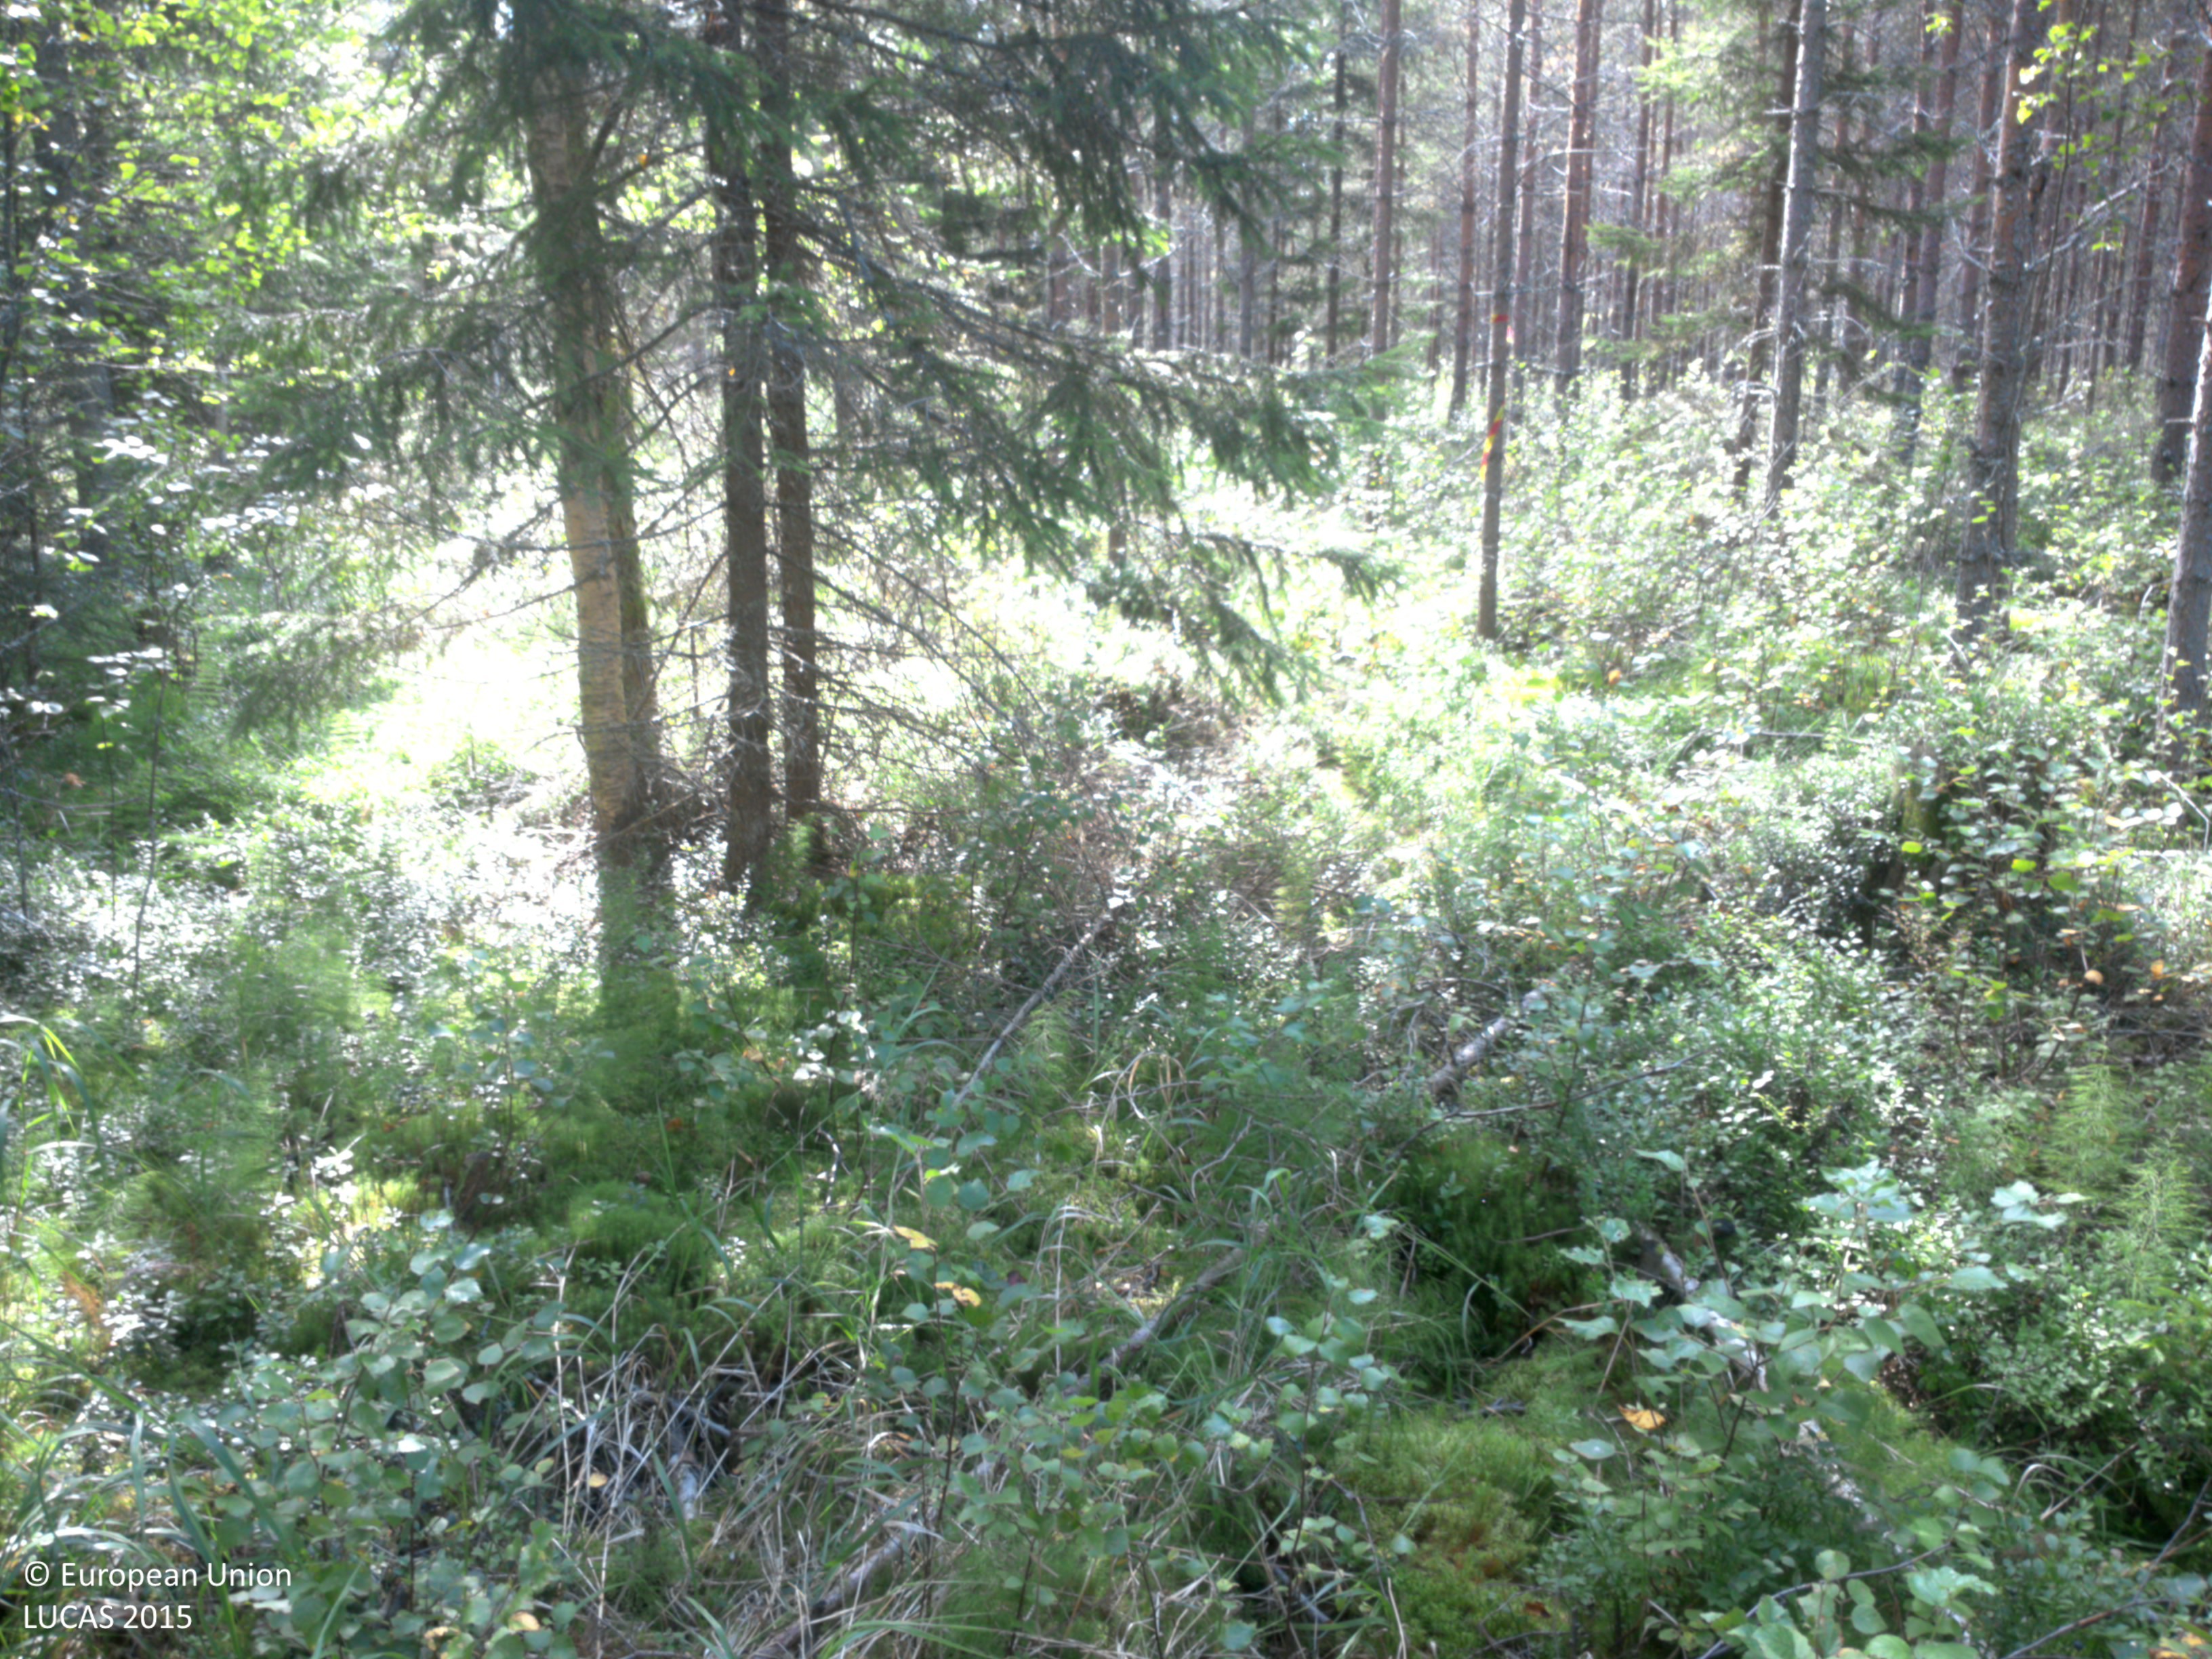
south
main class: Woodland
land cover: Other mixed woodland
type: boreal forest
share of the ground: 50 - 75 %
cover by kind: coniferous forest trees 40 %, shrubs 35 %, broadleaved forest trees 25 %
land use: Forestry
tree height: > 5 m
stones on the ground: < 10 %
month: August
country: SE
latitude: 63.5844
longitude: 19.5091
